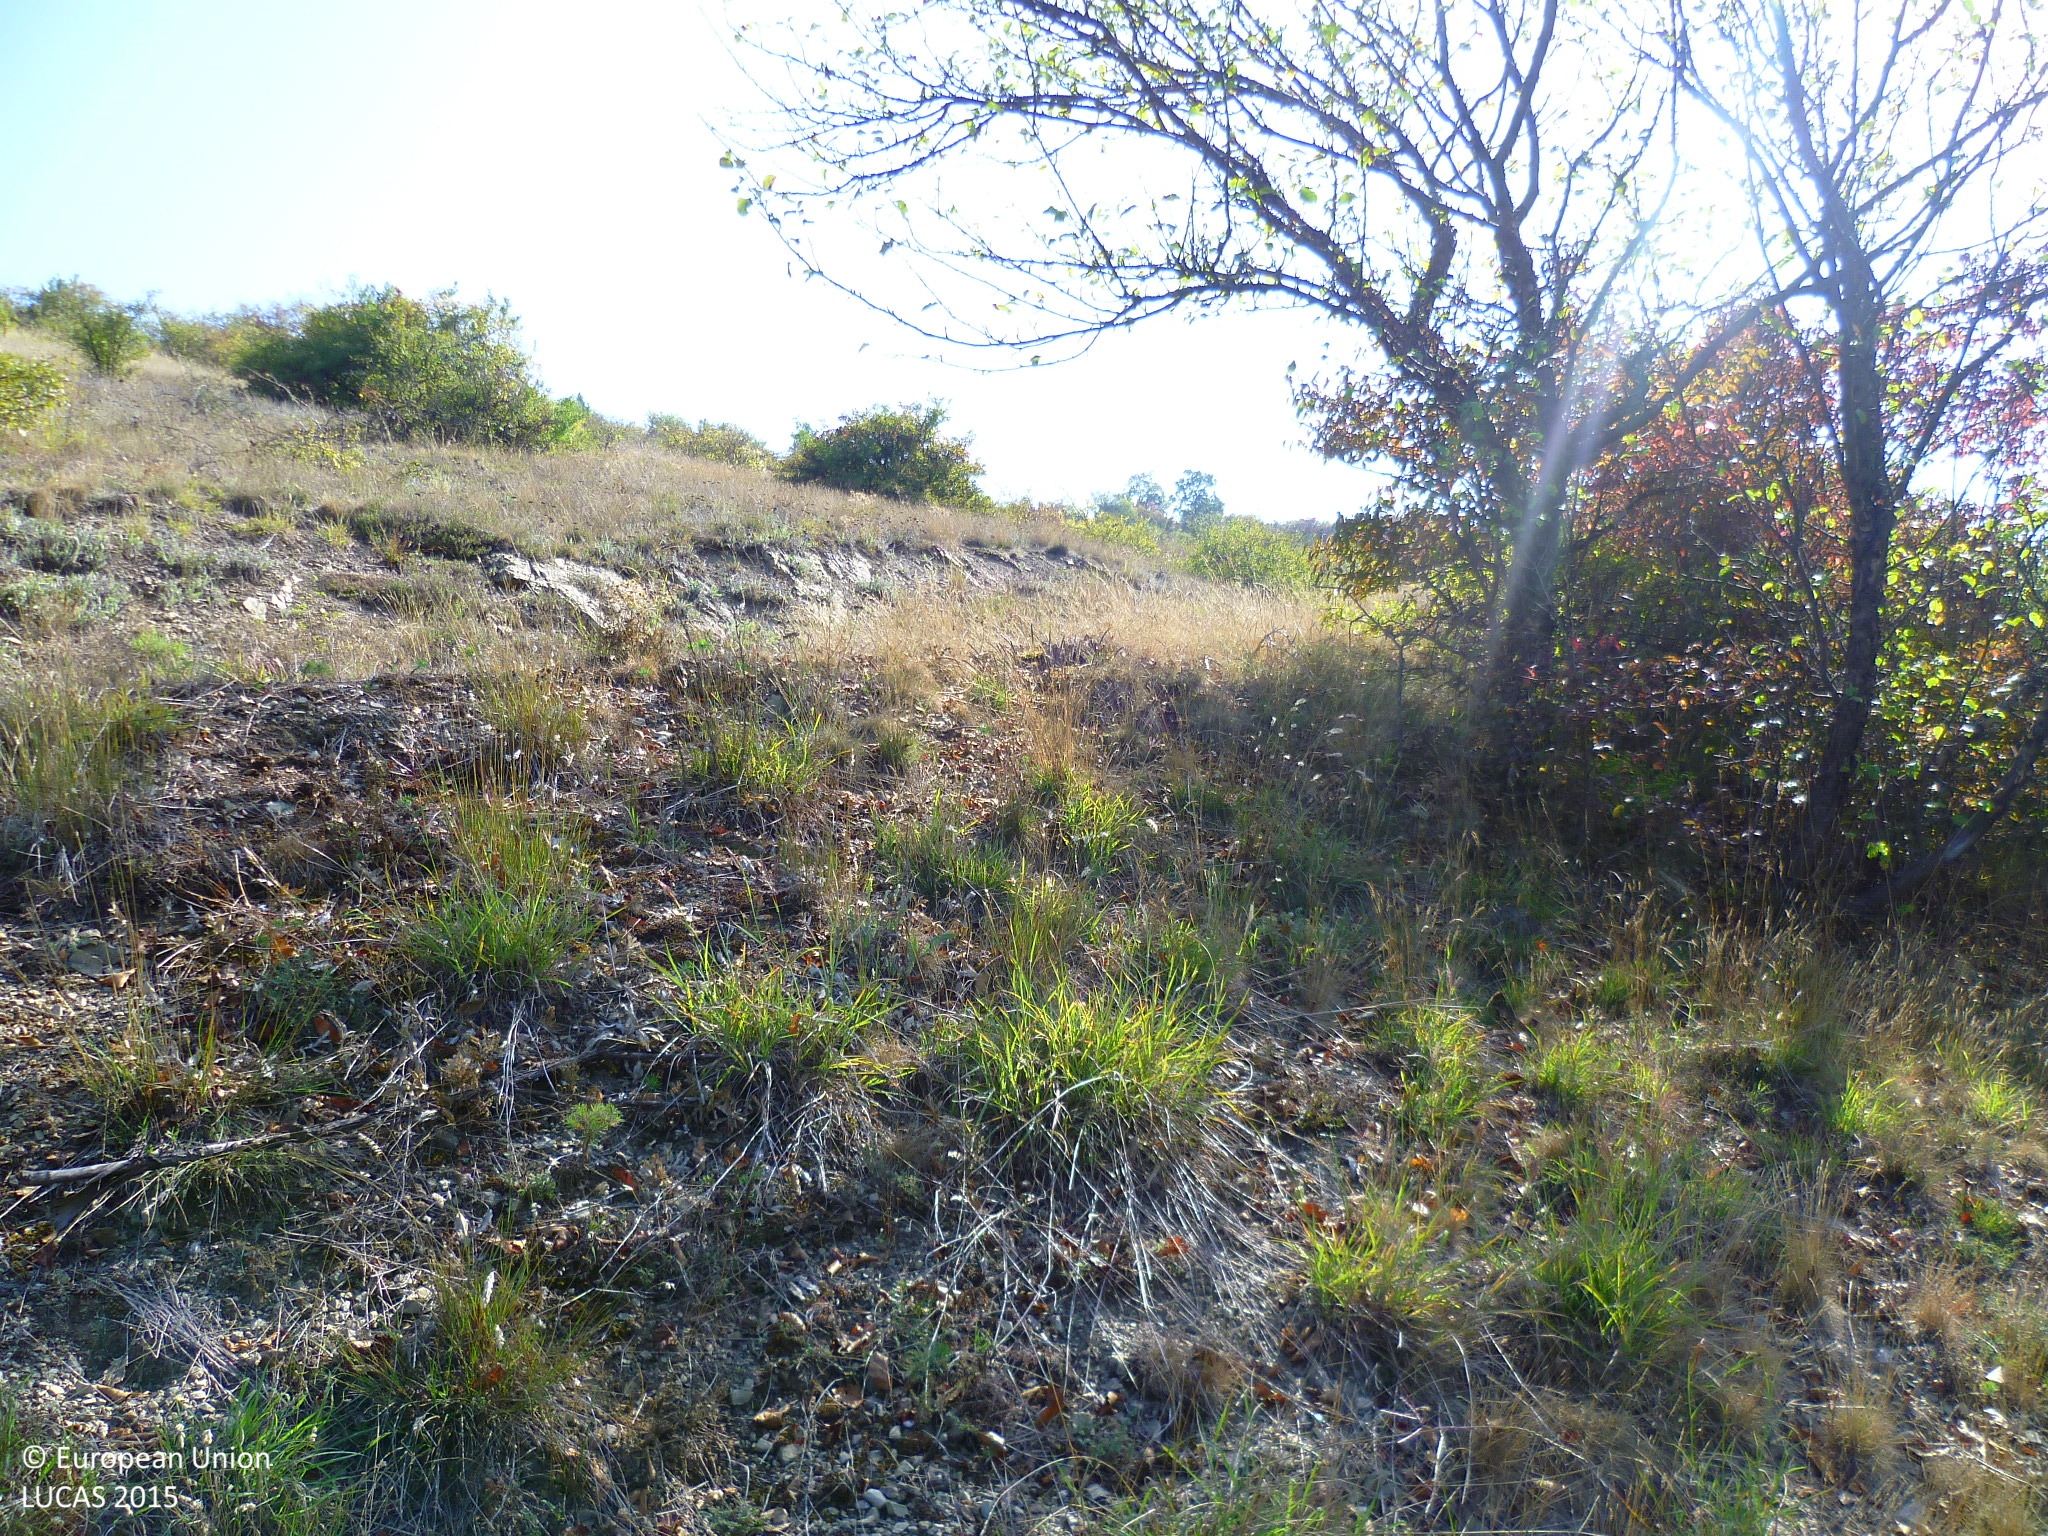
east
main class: Shrubland
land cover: Shrubland with sparse tree cover
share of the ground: 50 - 75 %
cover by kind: shrubs 55 %, herbaceous plants 40 %, broadleaved forest trees 5 %
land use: Semi-natural and natural areas not in use
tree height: < 5 m
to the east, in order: Shrubland with sparse tree cover; Tracks; Grassland with sparse tree/shrub cover; Shrubland without tree cover; Grassland with sparse tree/shrub cover
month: September
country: BG
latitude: 42.8816
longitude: 22.9226
